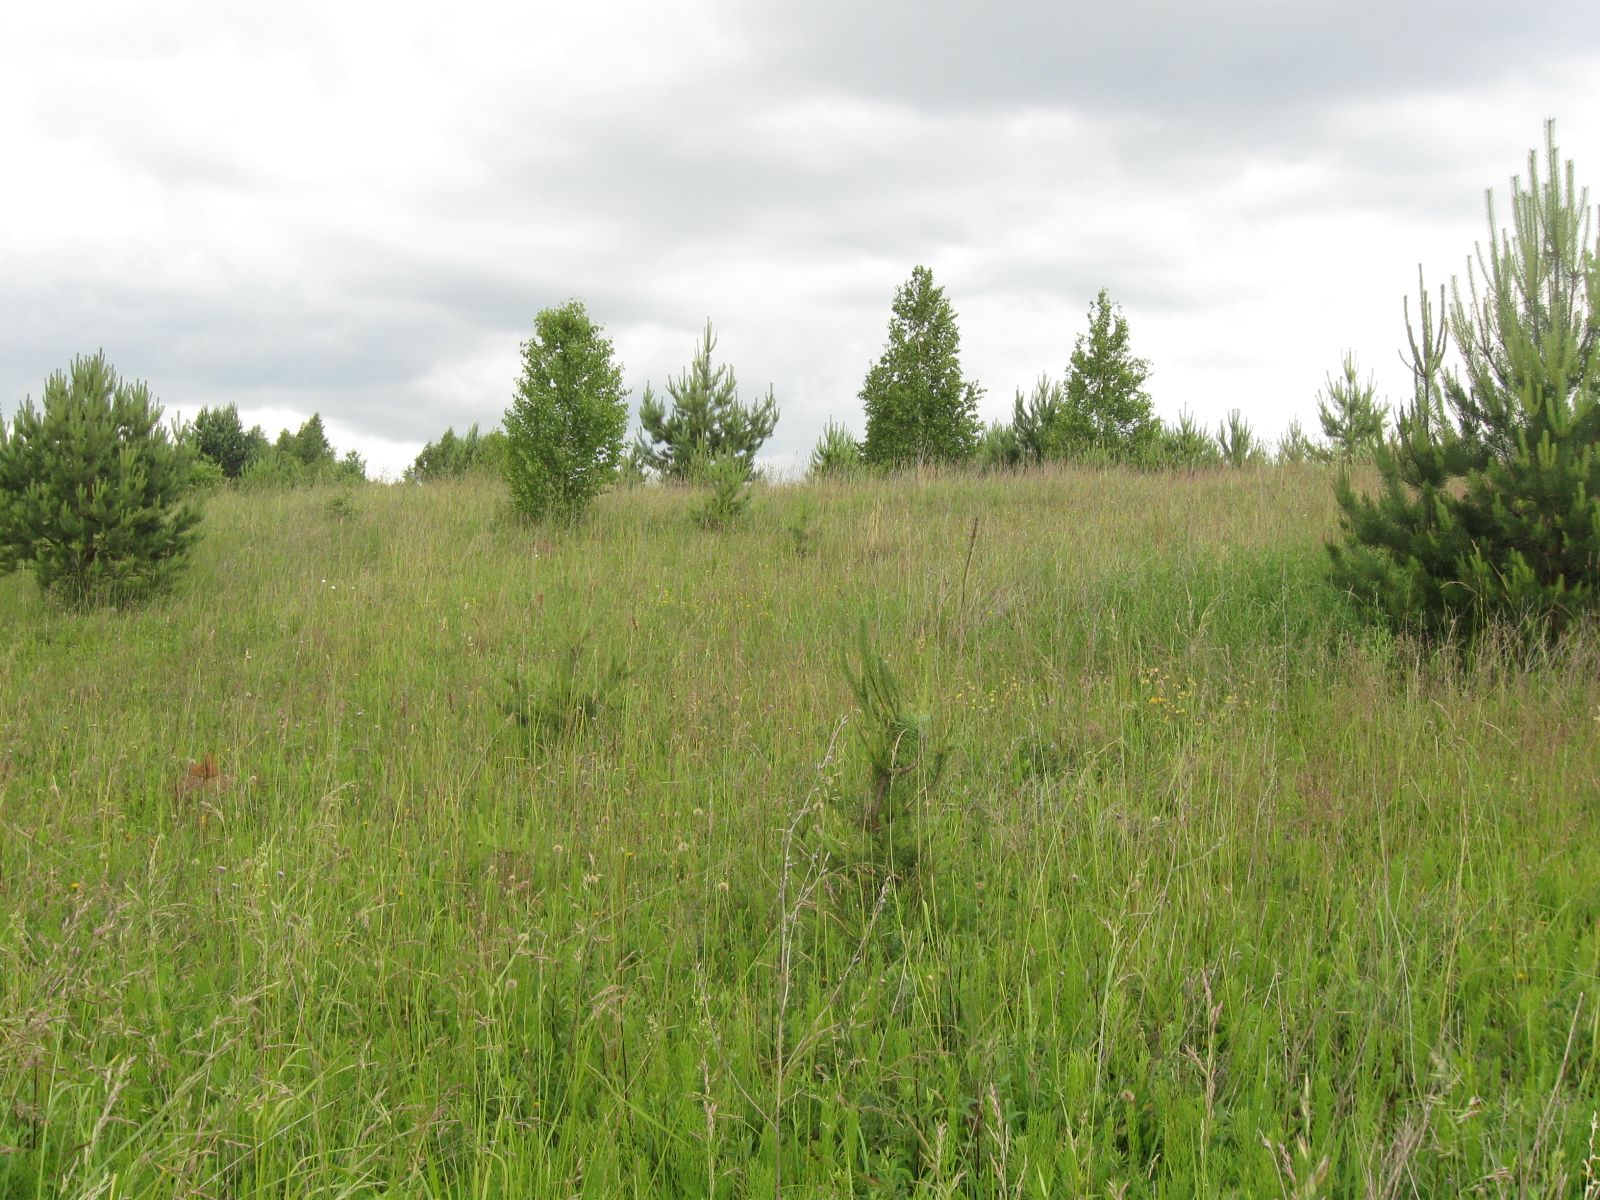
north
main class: Grassland
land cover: Grassland with sparse tree/shrub cover
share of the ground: > 75 %
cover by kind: herbaceous plants 90 %, broadleaved forest trees 5 %, shrubs 5 %
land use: Agriculture (excluding fallow land and kitchen gardens)
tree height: < 5 m
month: June
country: LT
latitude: 54.5638
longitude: 24.4064
